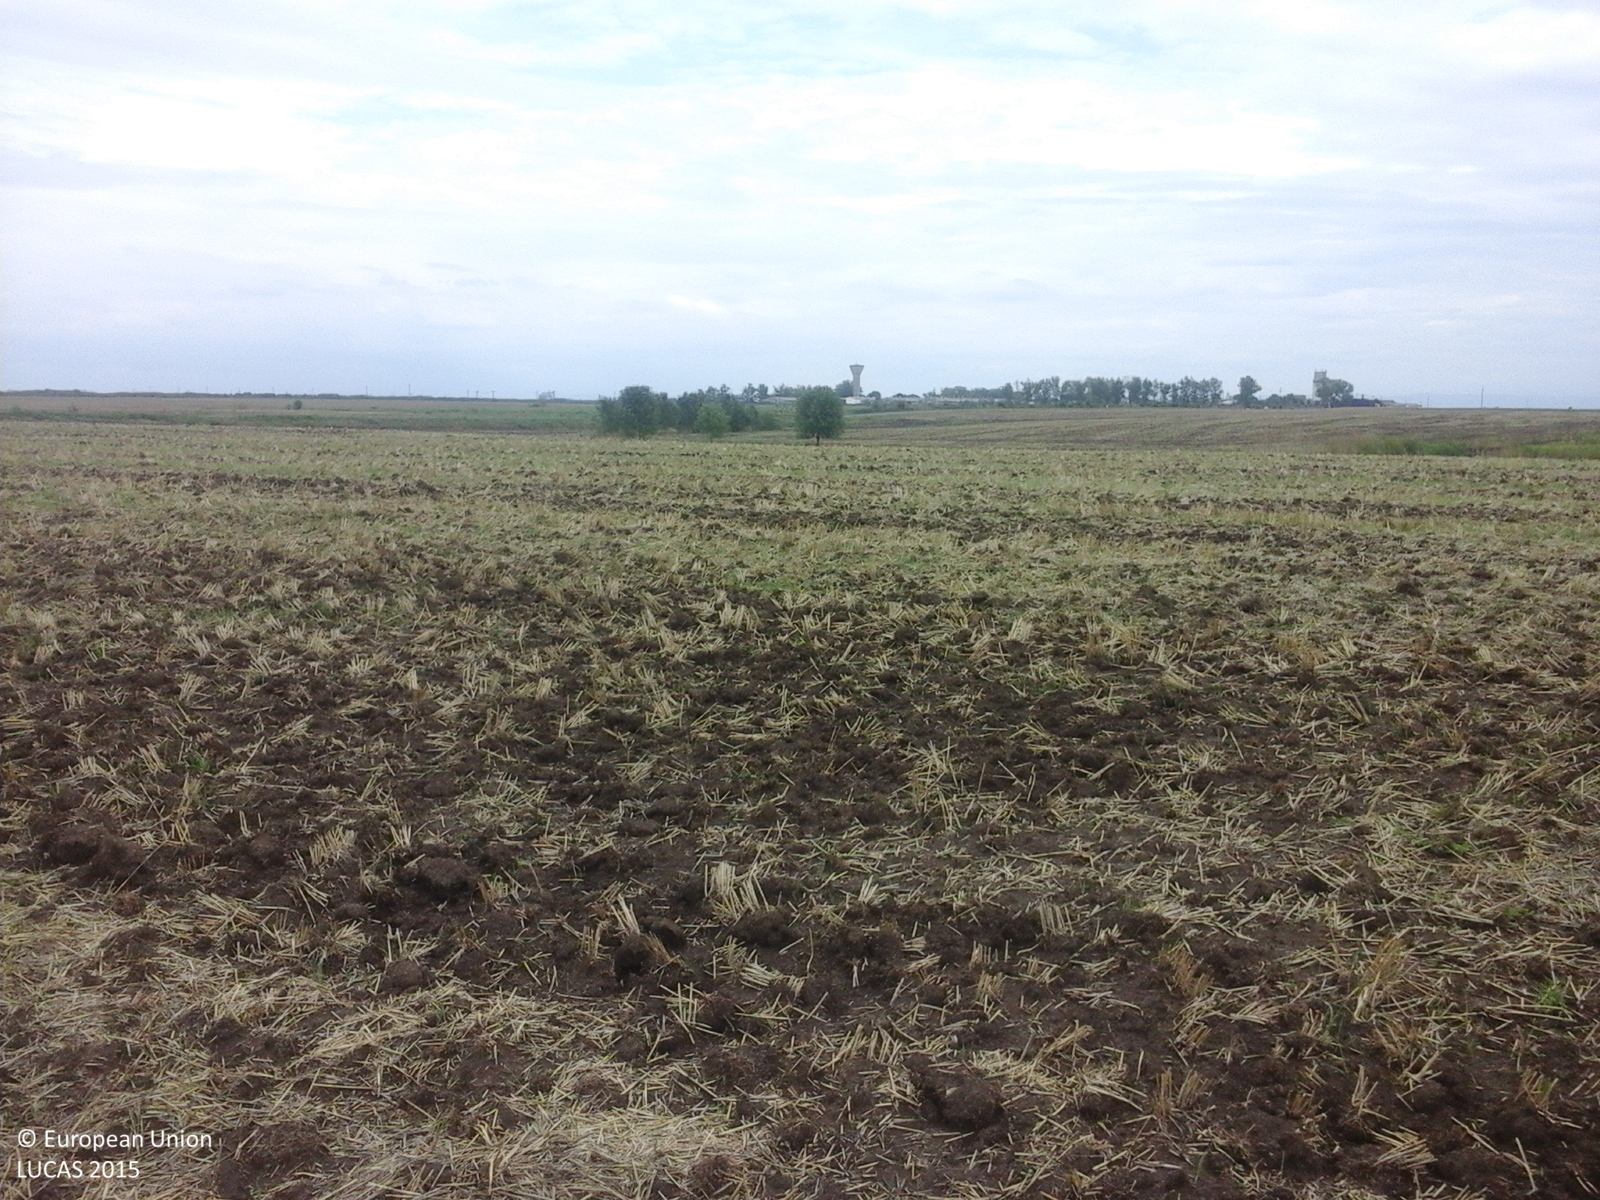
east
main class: Cropland
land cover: Common wheat
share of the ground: < 10 %
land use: Agriculture (excluding fallow land and kitchen gardens)
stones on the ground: < 10 %
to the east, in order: Common wheat; Grass margins; Lines of trees; Ditches and canals; Grass margins; Common wheat; Grass margins; Lines of trees; Ditches and canals
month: August
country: RO
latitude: 45.4420
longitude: 21.2927
